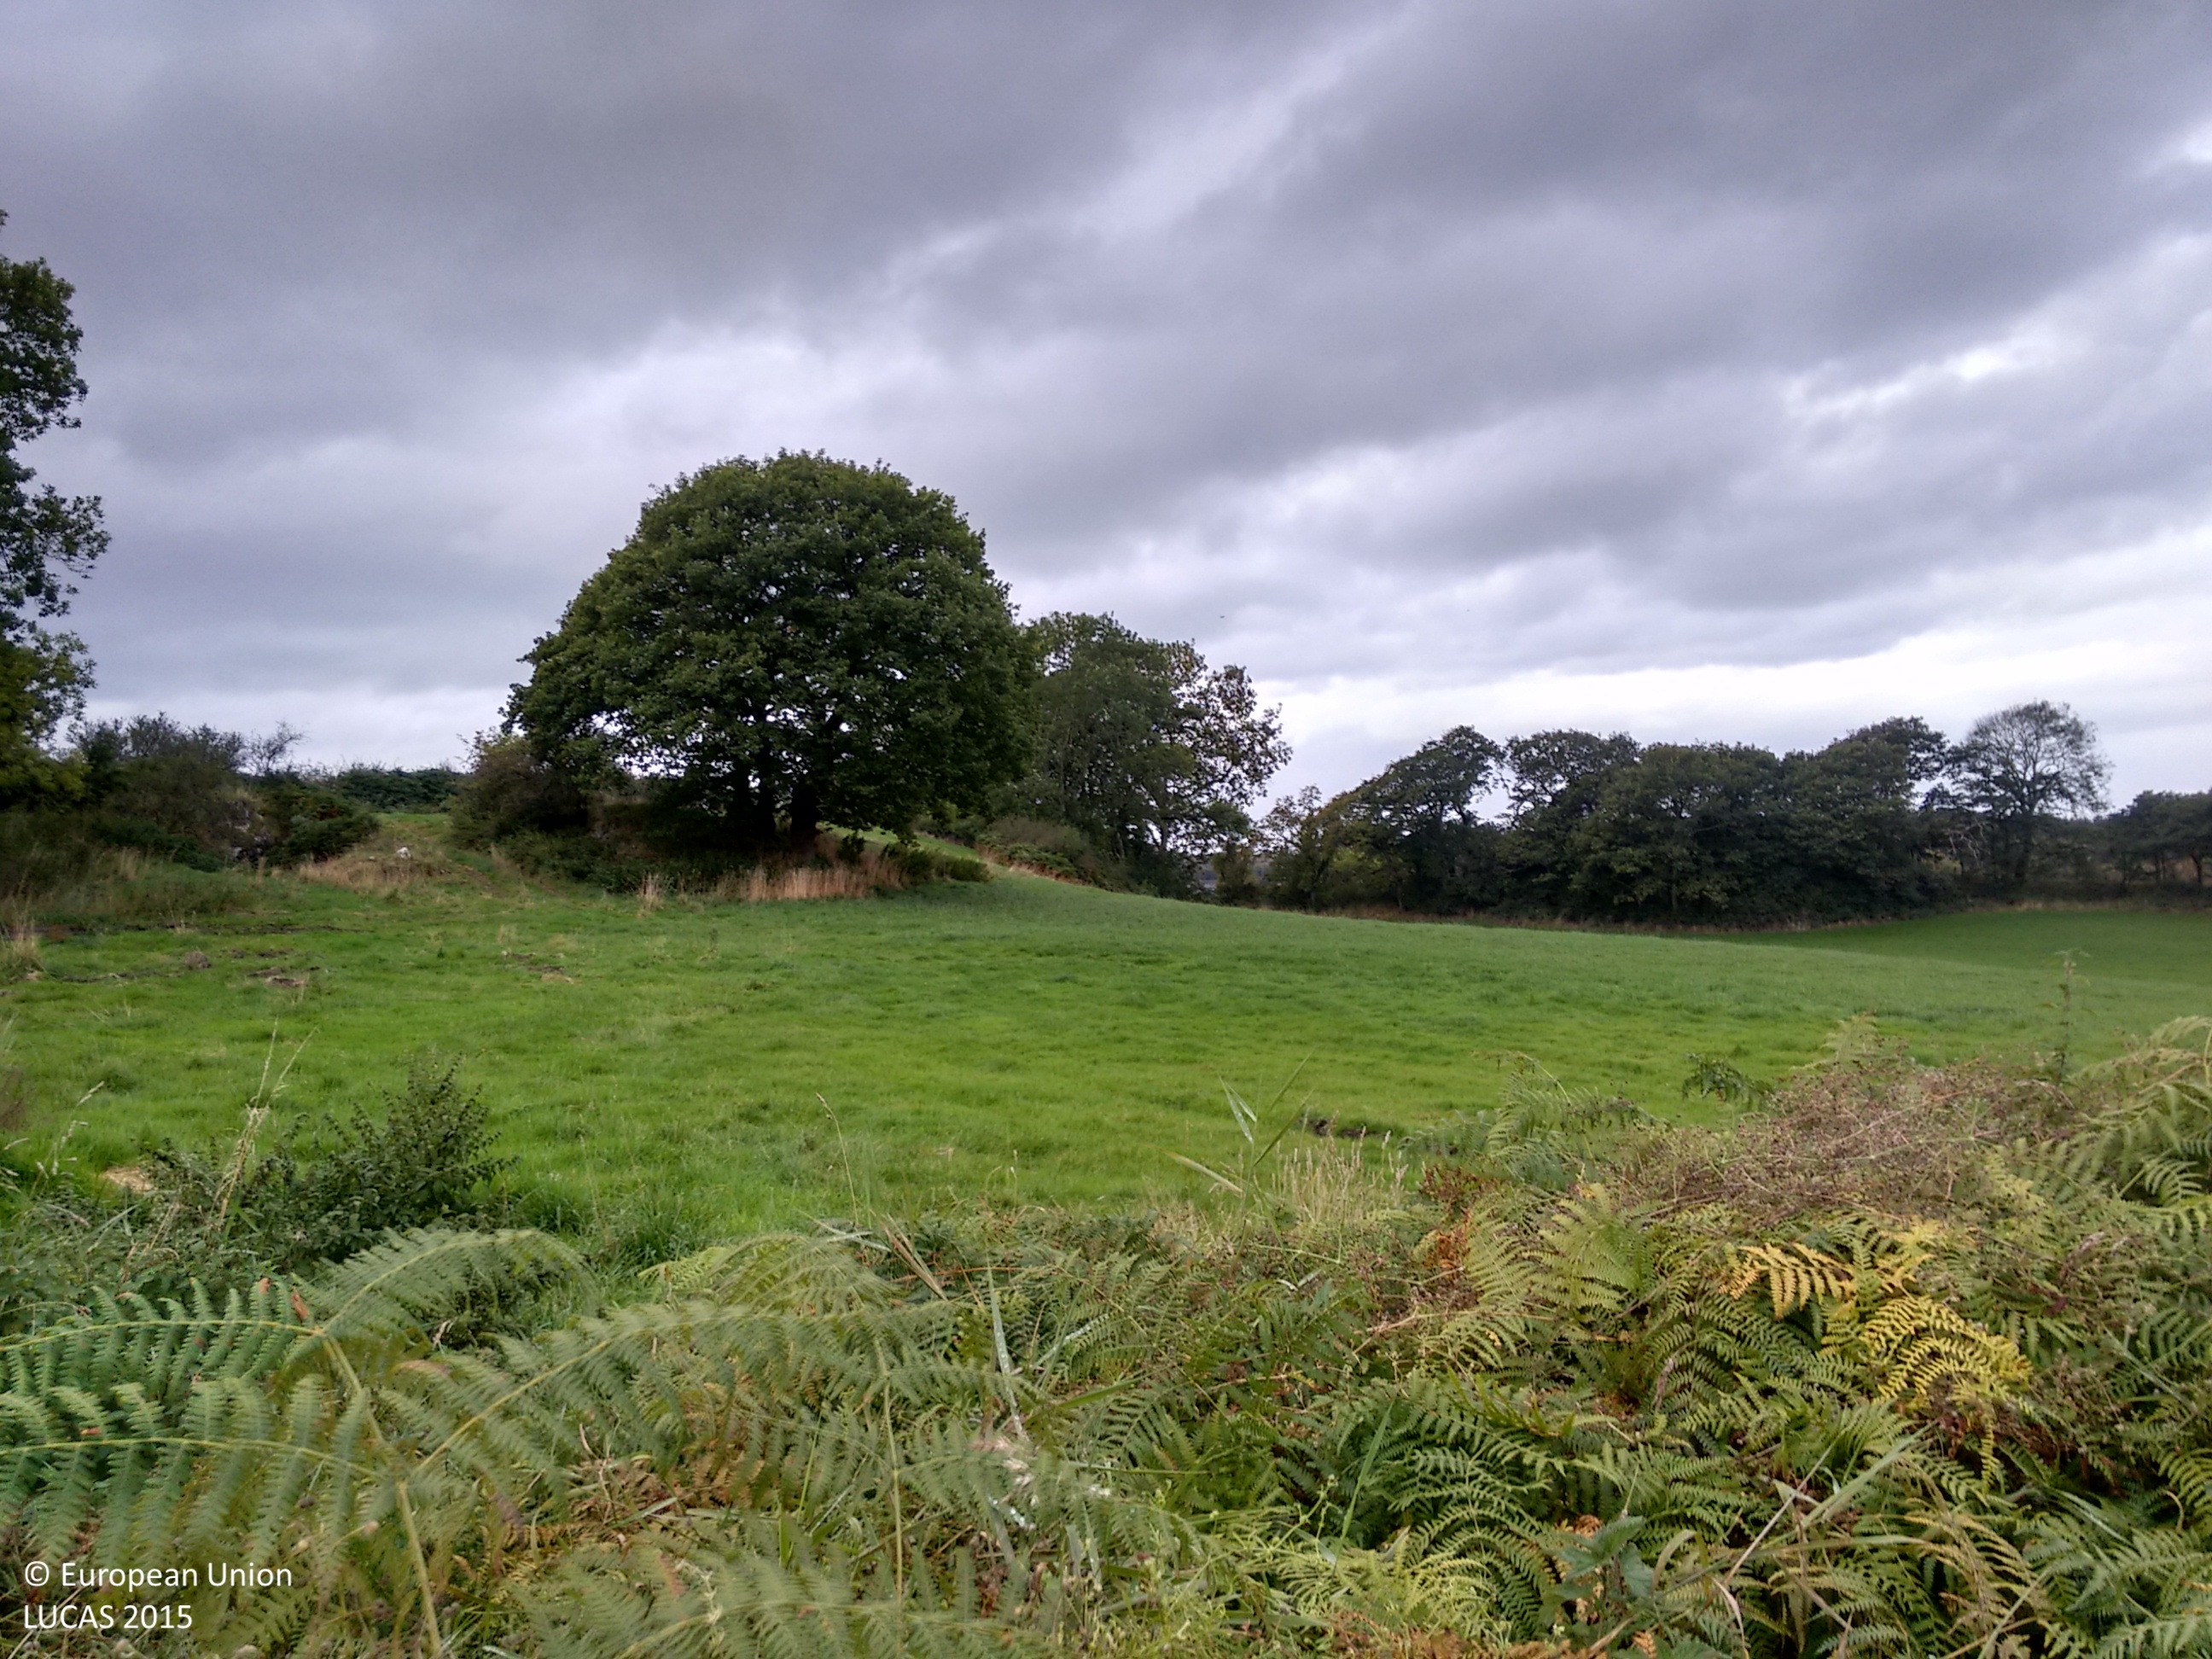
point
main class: Grassland
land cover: Grassland with sparse tree/shrub cover
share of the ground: > 75 %
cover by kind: herbaceous plants 95 %, broadleaved forest trees 5 %
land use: Agriculture (excluding fallow land and kitchen gardens)
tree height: > 5 m
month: October
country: GB
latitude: 52.5114
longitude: -3.9890
